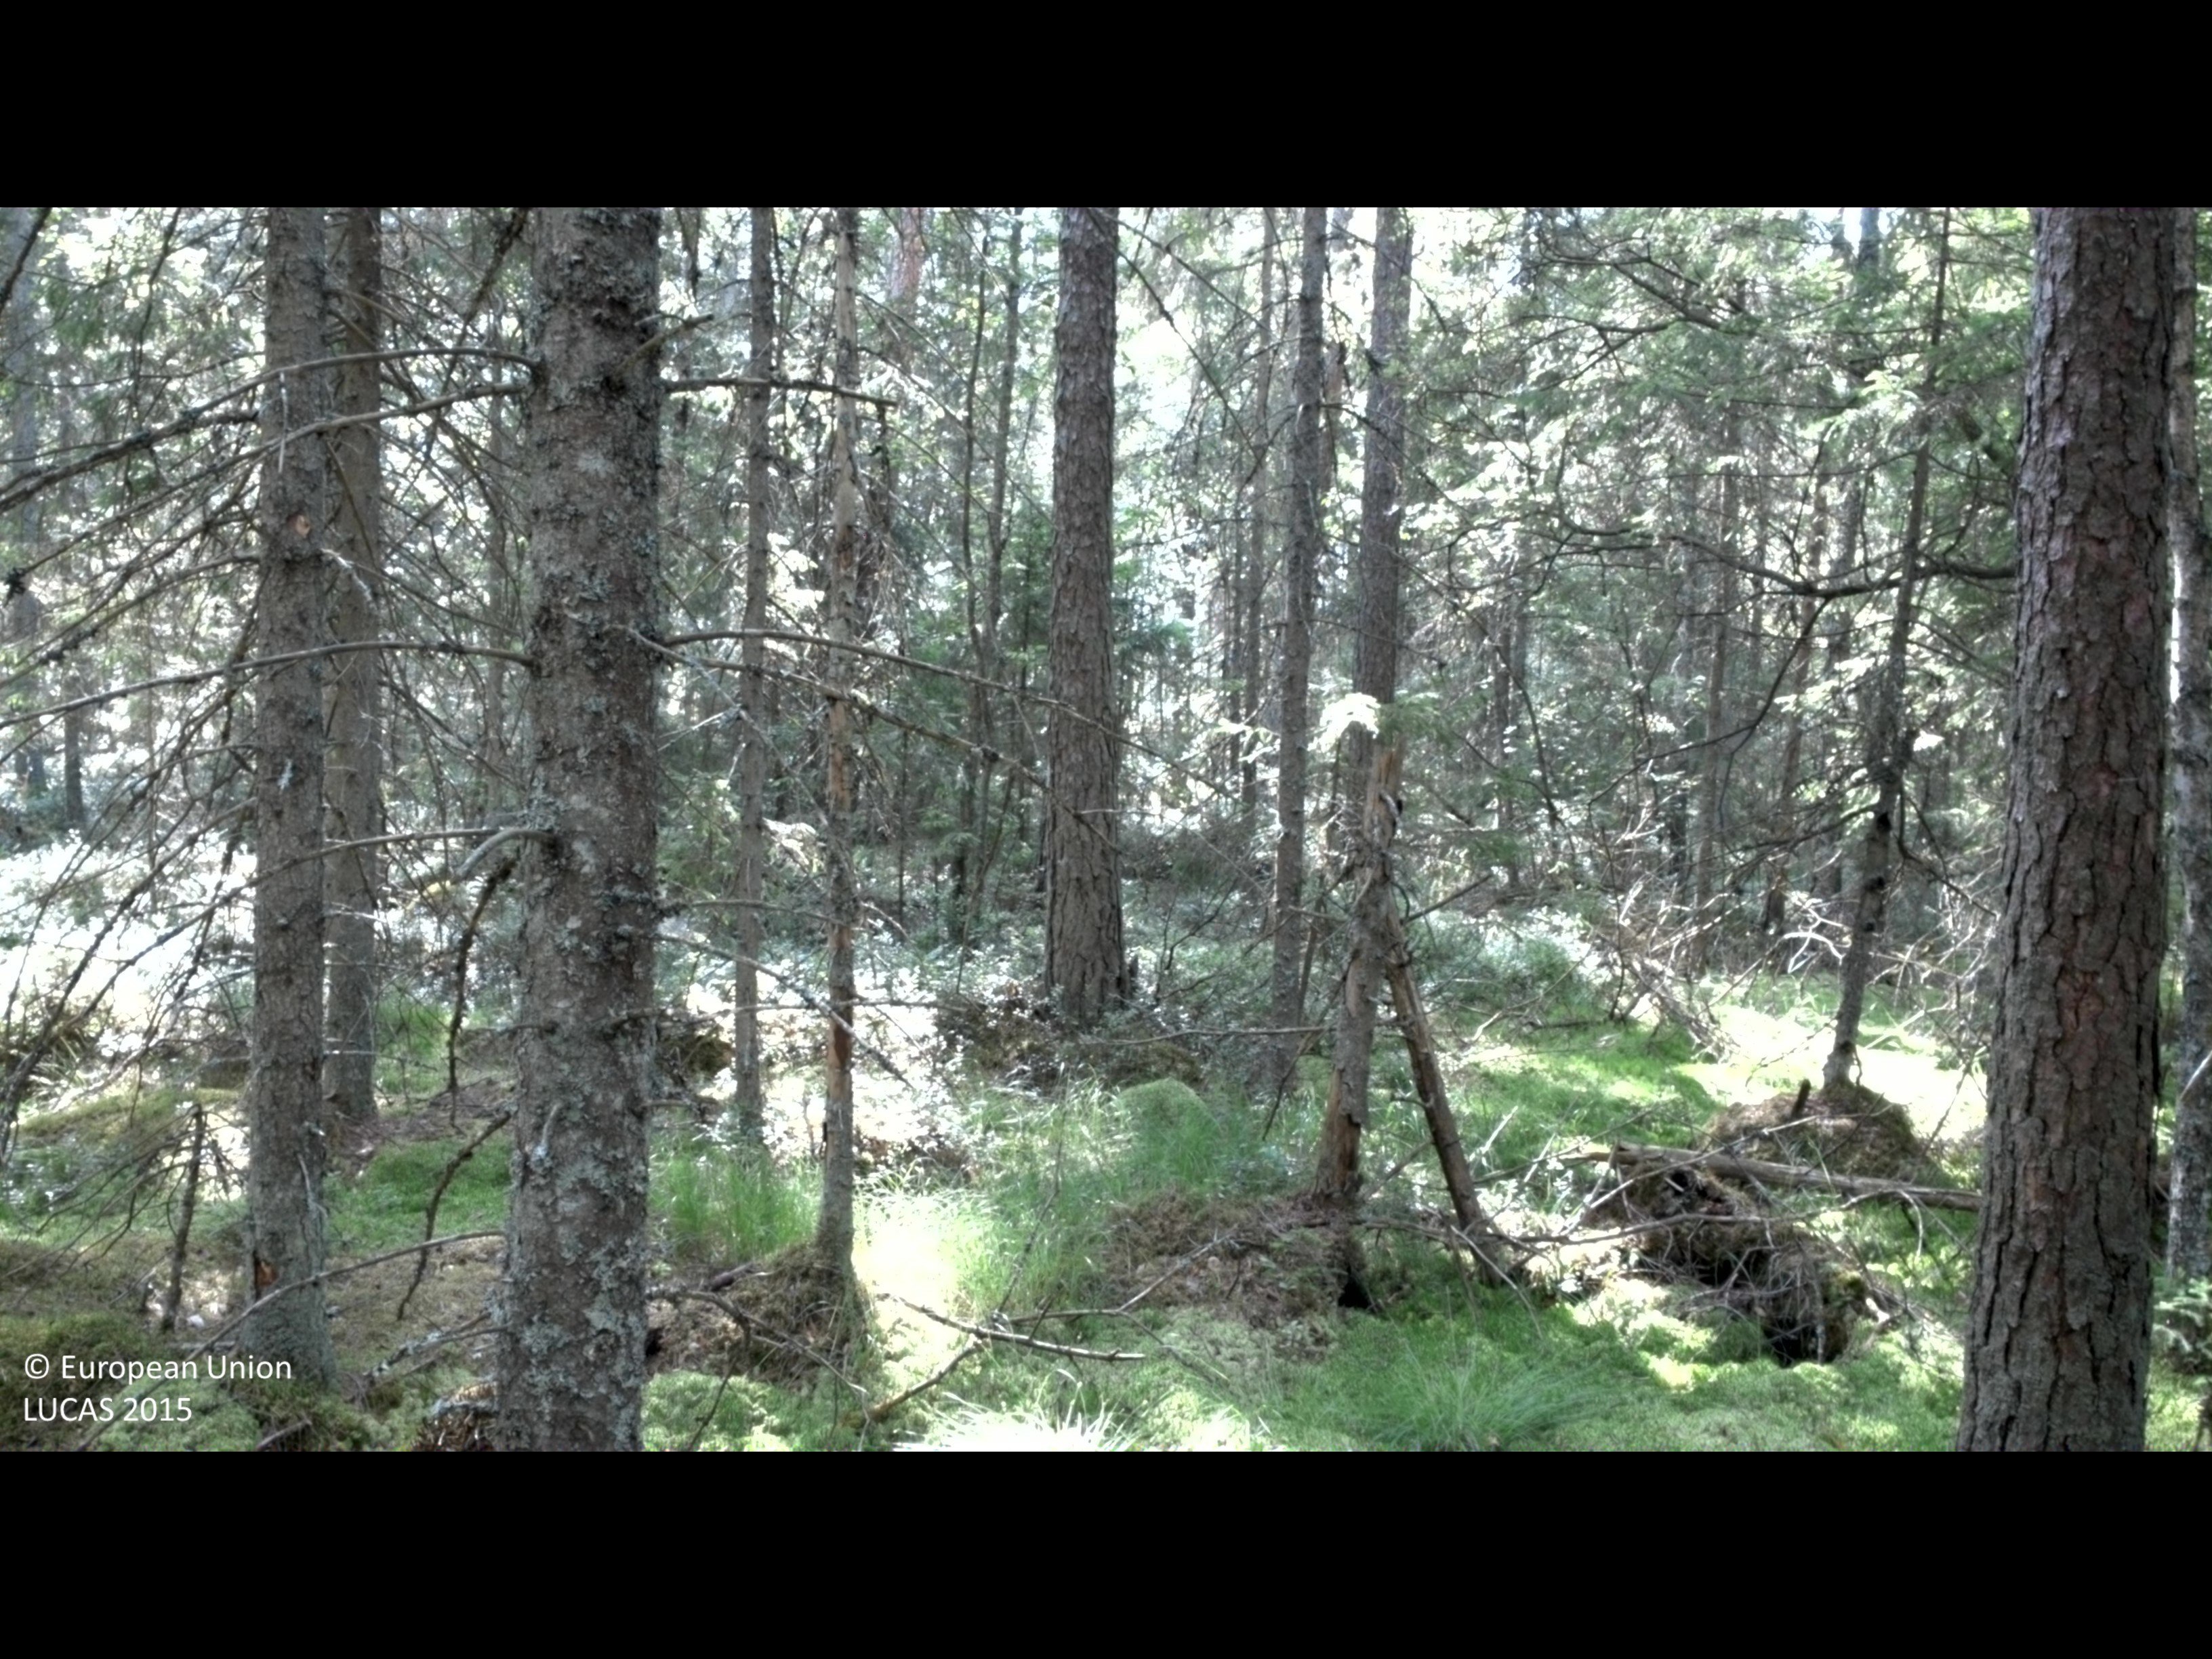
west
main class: Woodland
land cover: Spruce dominated coniferous woodland
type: boreal forest
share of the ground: 50 - 75 %
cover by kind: coniferous forest trees 55 %, shrubs 25 %, broadleaved forest trees 15 %, lichens and mosses 5 %
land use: Forestry
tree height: > 5 m
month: July
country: SE
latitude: 56.4580
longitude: 14.2976
